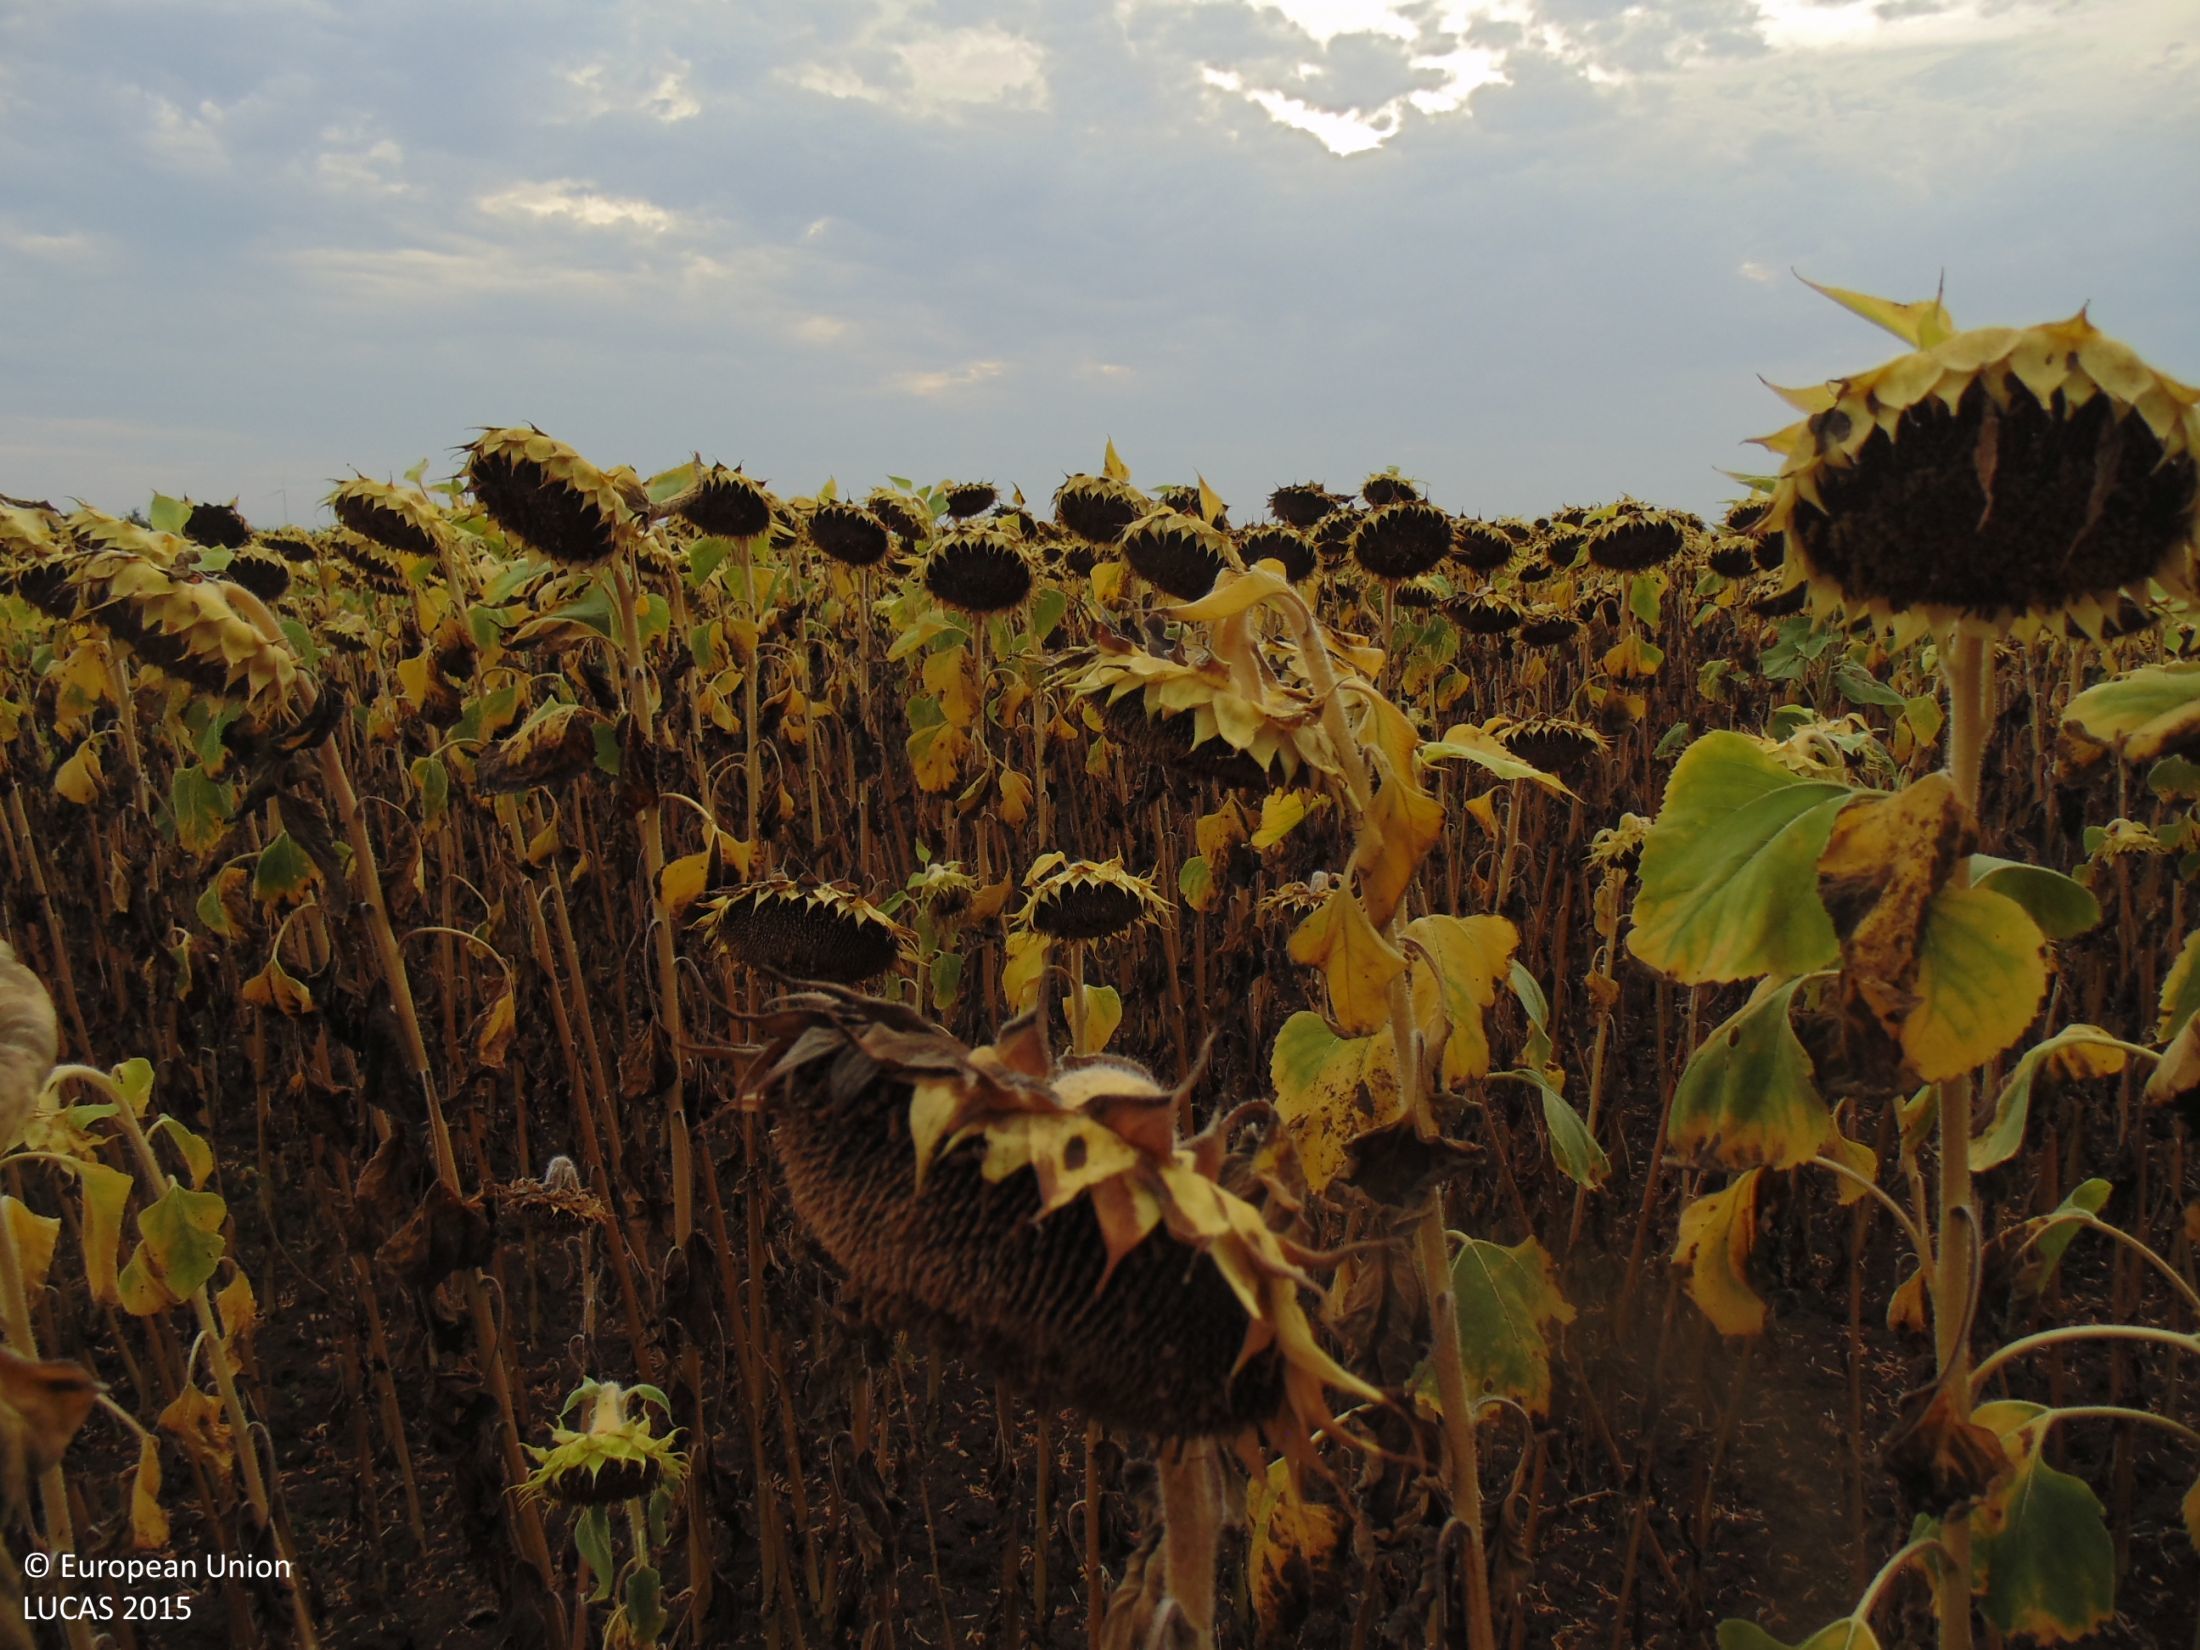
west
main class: Cropland
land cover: Sunflower
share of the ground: > 75 %
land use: Agriculture (excluding fallow land and kitchen gardens)
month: August
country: BG
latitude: 43.4954
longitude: 28.5261
